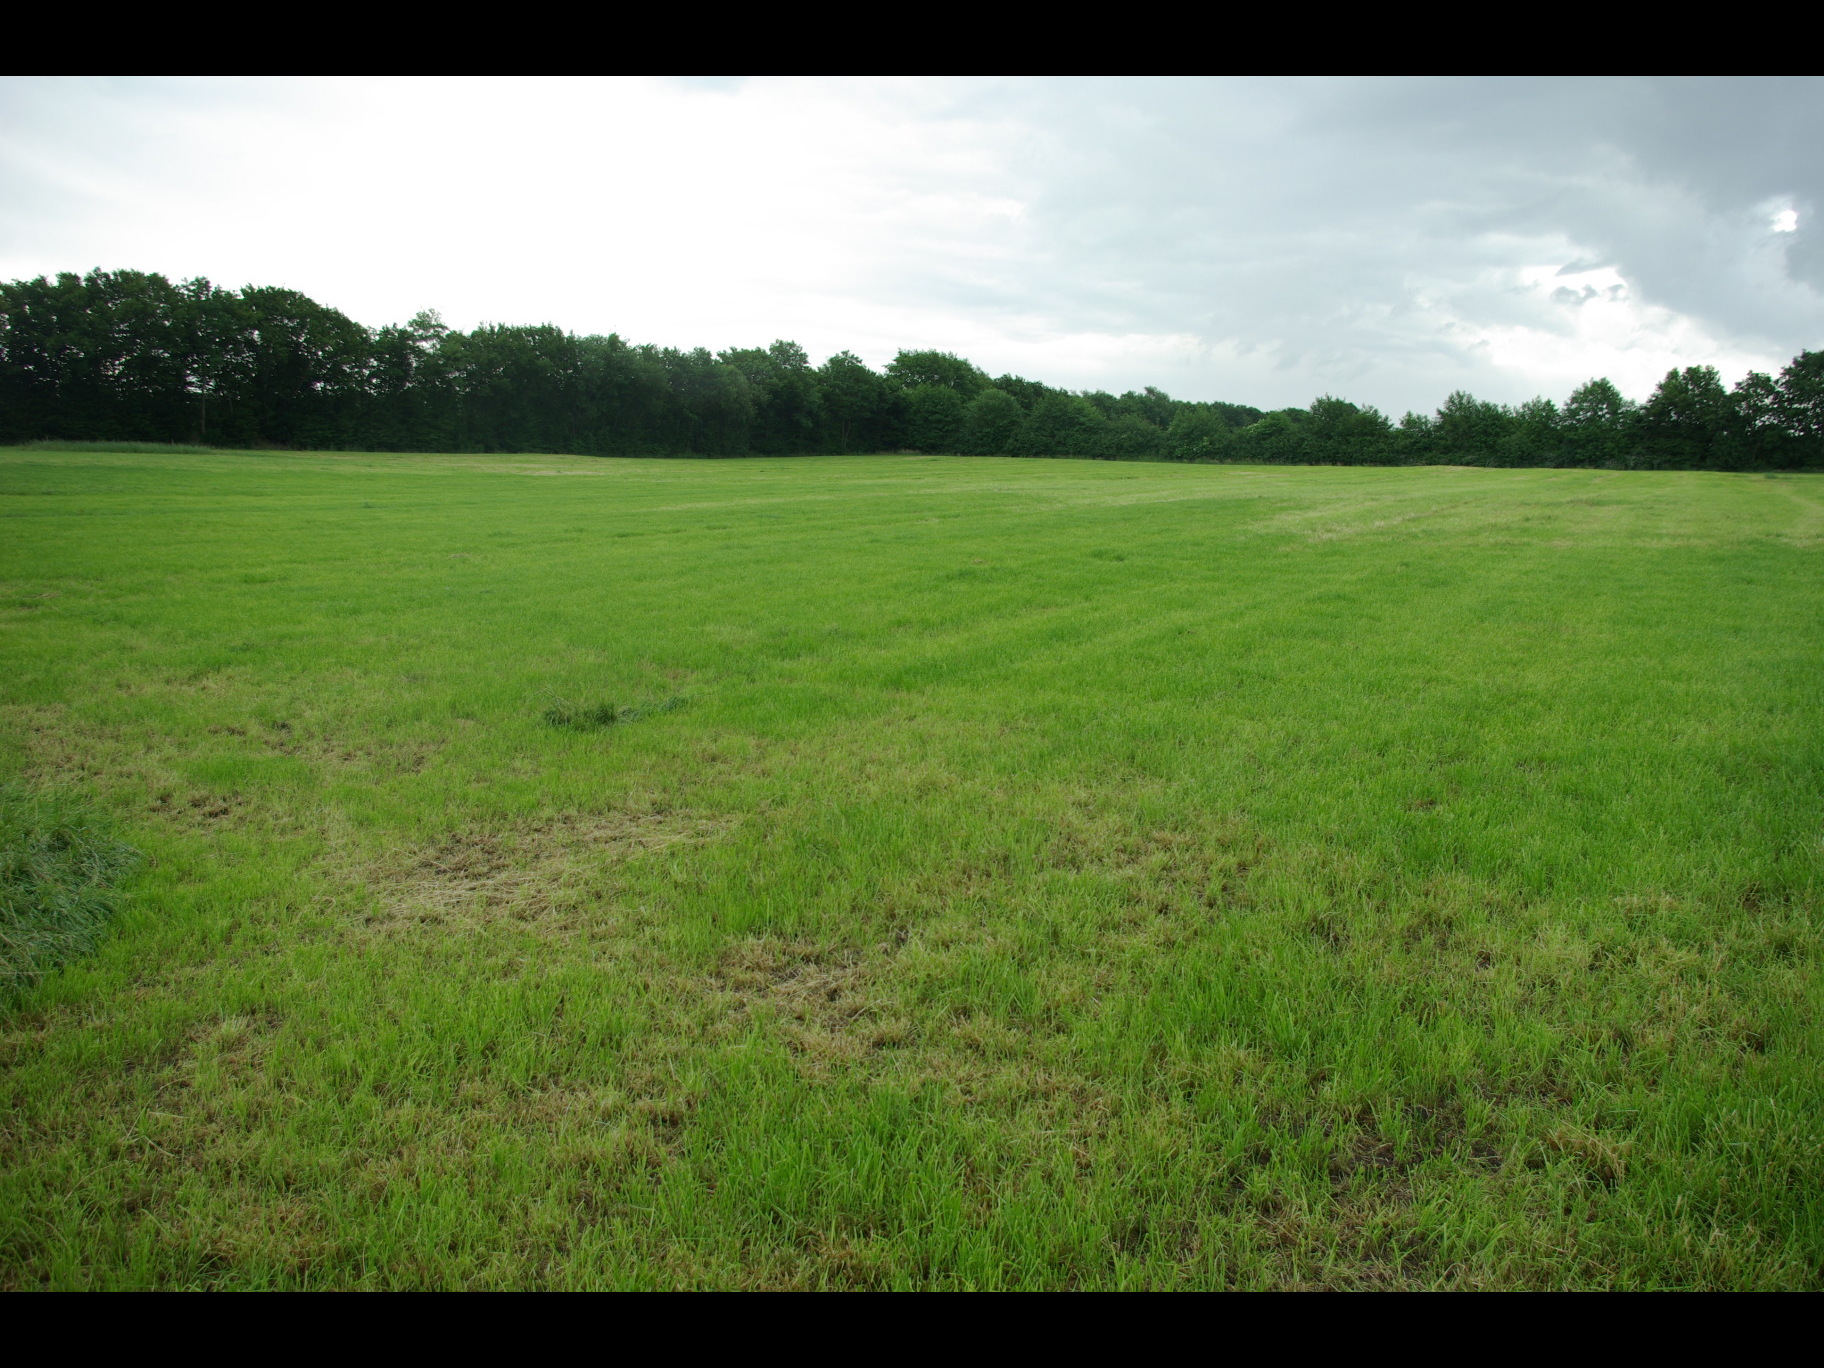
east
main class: Grassland
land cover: Grassland without tree/shrub cover
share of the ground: > 75 %
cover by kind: herbaceous plants 100 %
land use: Agriculture (excluding fallow land and kitchen gardens)
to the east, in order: Grassland without tree/shrub cover; Ditches and canals; Shrubland with sparse tree cover; Grassland without tree/shrub cover; Shruby margins; Broadleaved woodland; Ditches and canals; Paved roads, cycling and walking lanes; Ditches and canals; Broadleaved woodland; Grassland without tree/shrub cover; Broadleaved woodland; Grassland without tree/shrub cover
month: July
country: DE
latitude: 54.1380
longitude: 9.5564
